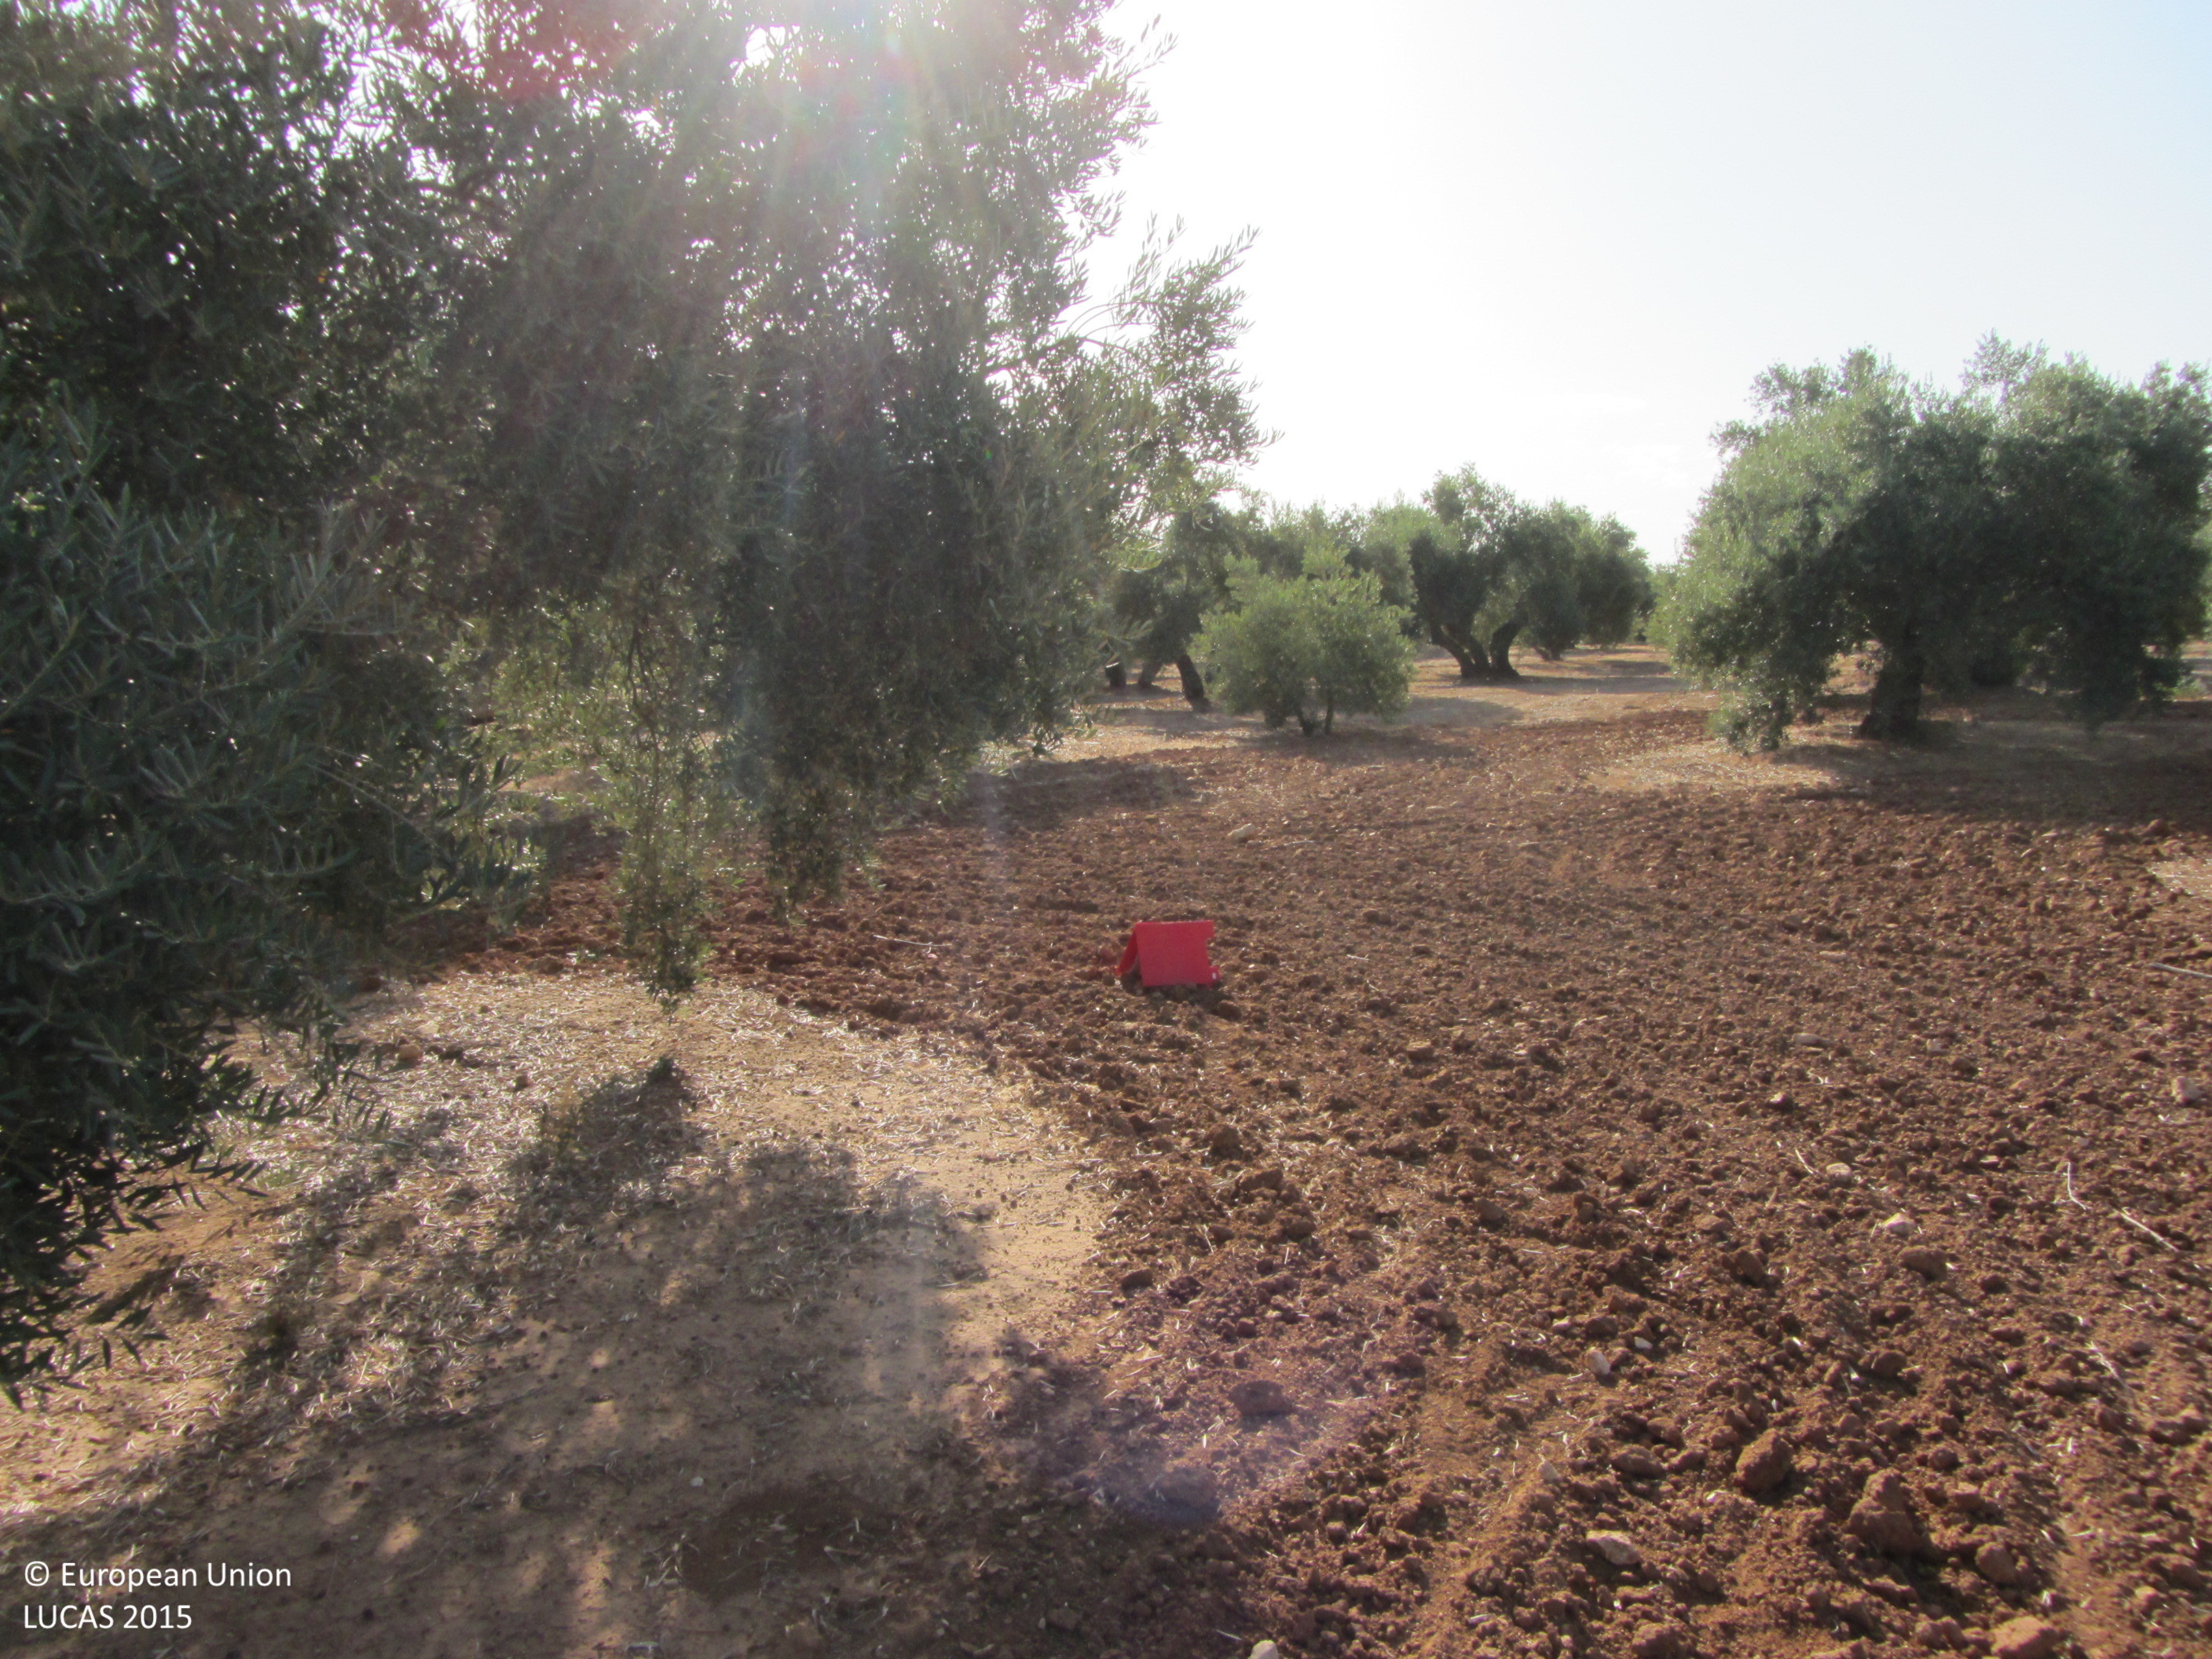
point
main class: Cropland
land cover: Olive groves
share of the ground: 25 - 50 %
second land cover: Other bare soil
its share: > 75 %
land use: Agriculture (excluding fallow land and kitchen gardens)
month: July
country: ES
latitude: 38.0552
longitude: -3.4378
